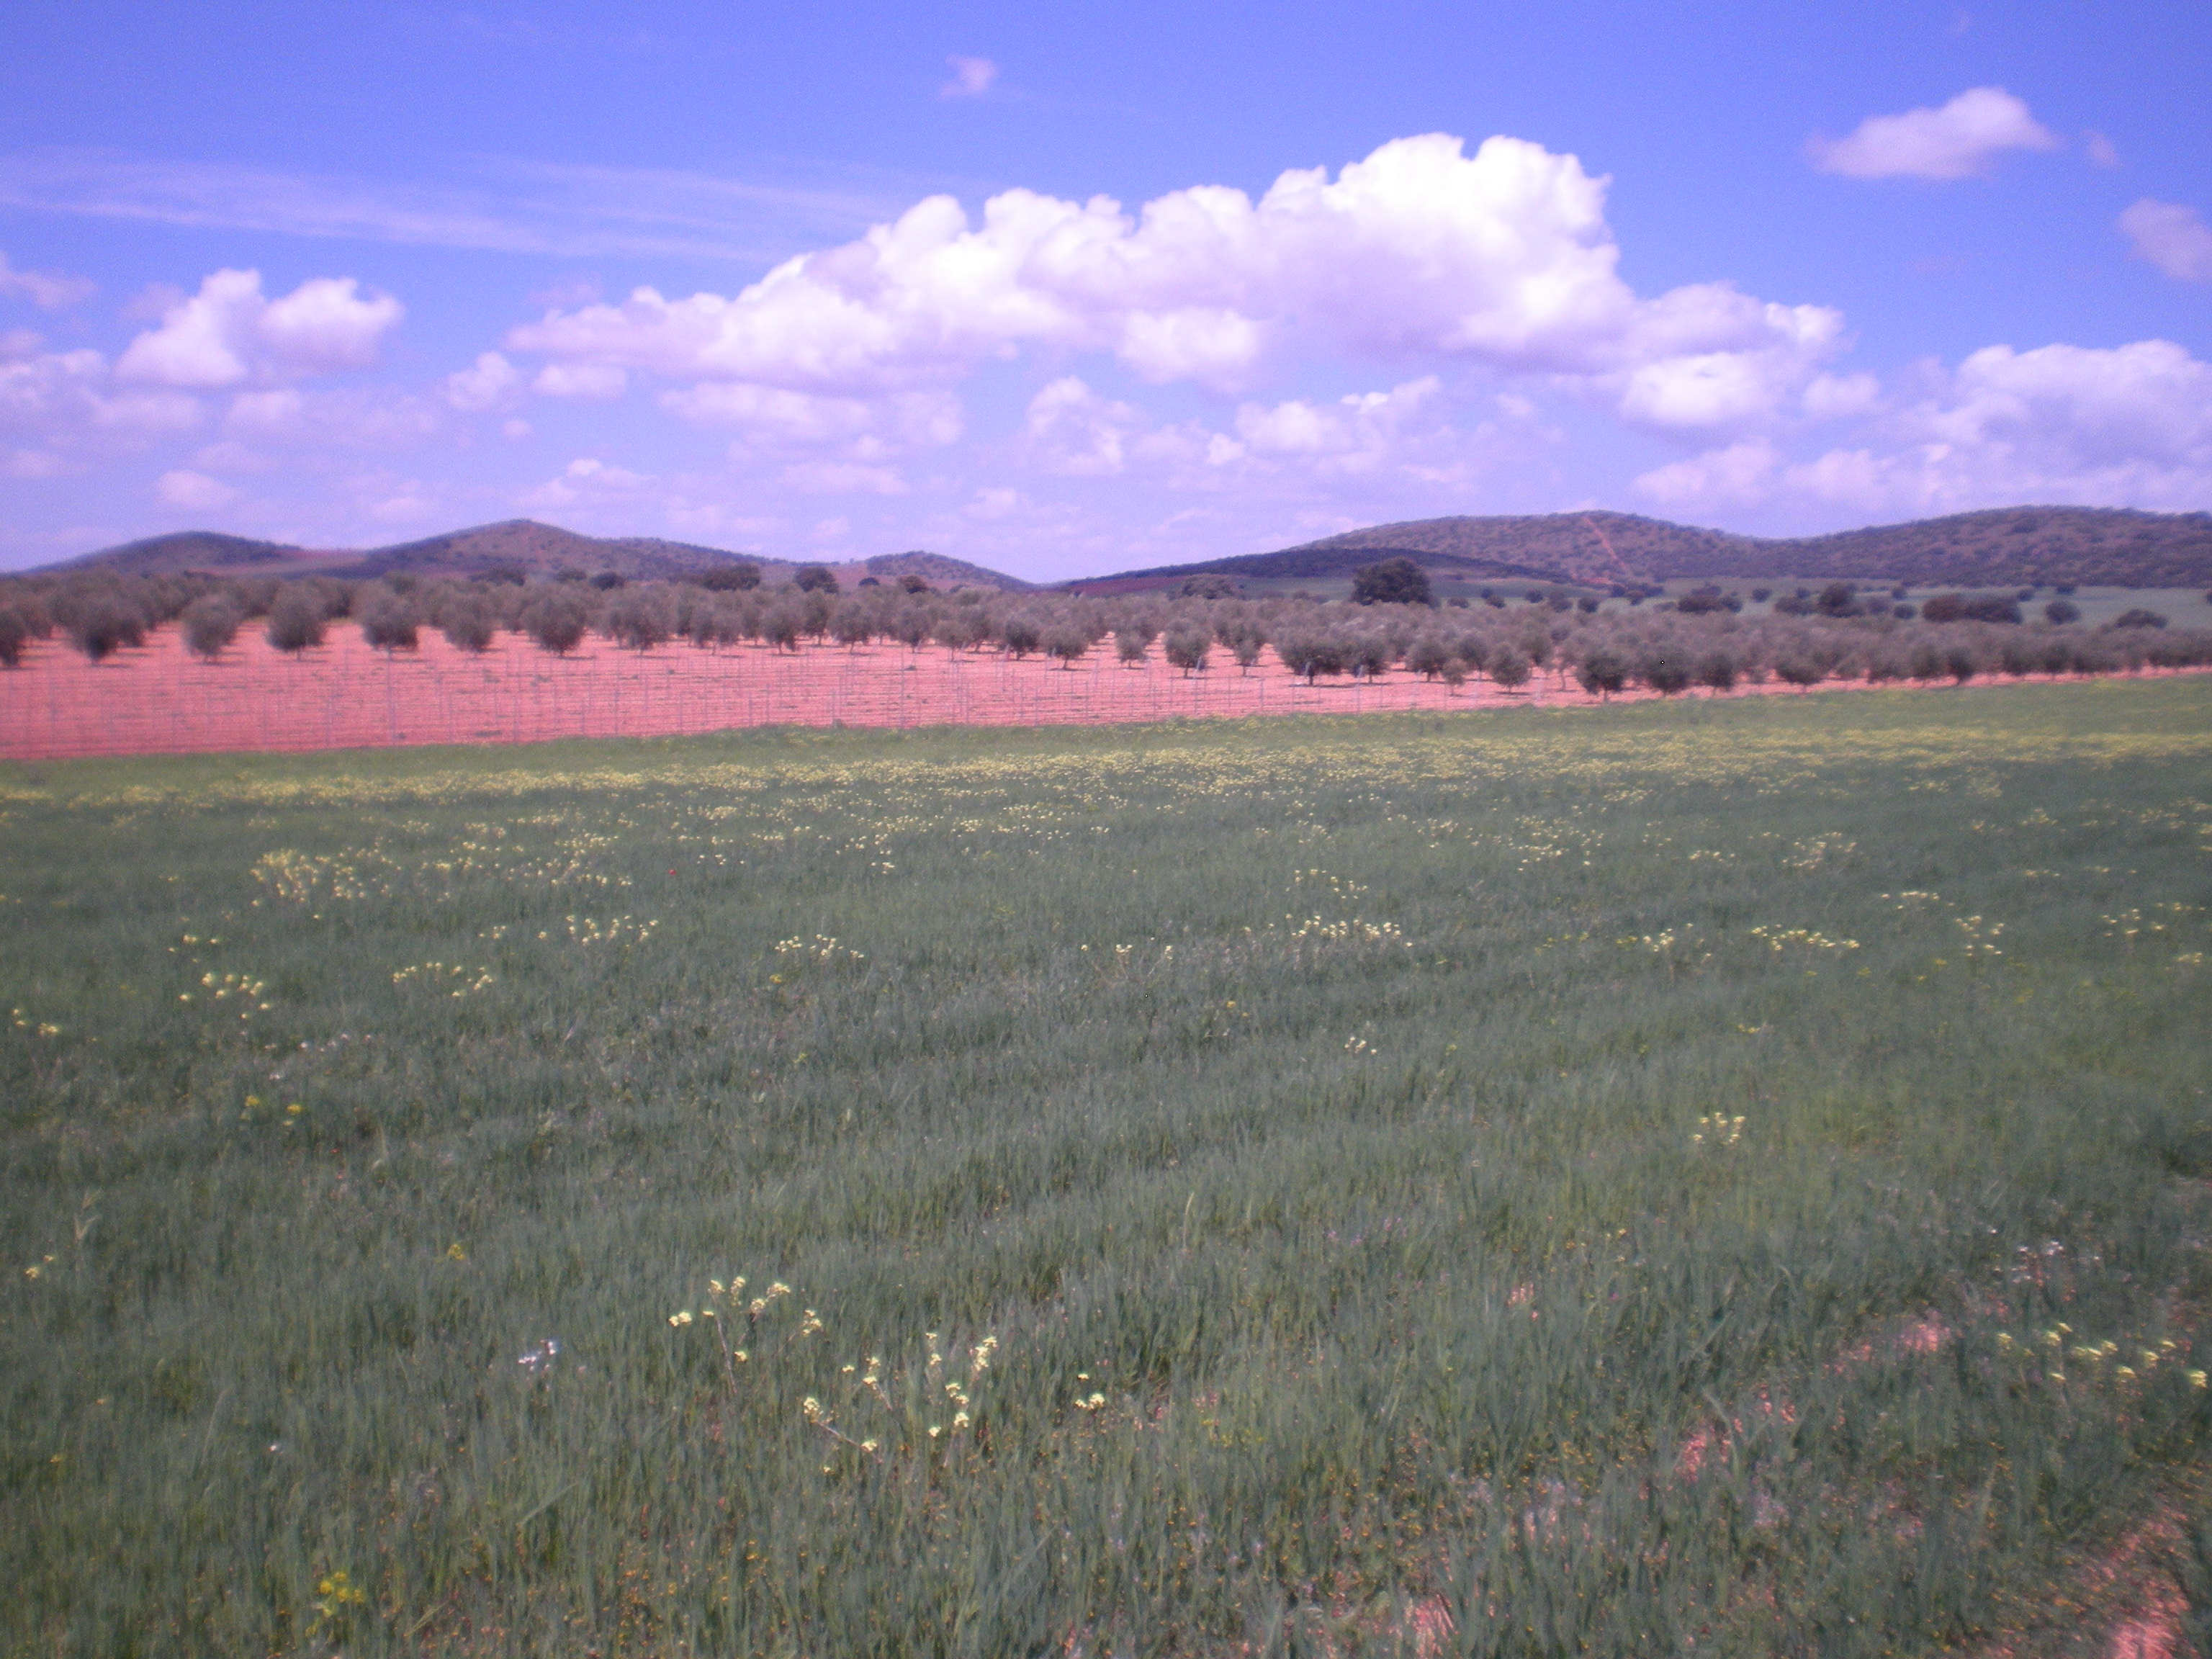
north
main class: Cropland
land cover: Oats
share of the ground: > 75 %
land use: Agriculture (excluding fallow land and kitchen gardens)
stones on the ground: 25 - 50 %
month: April
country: ES
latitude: 38.7033
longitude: -3.5227
